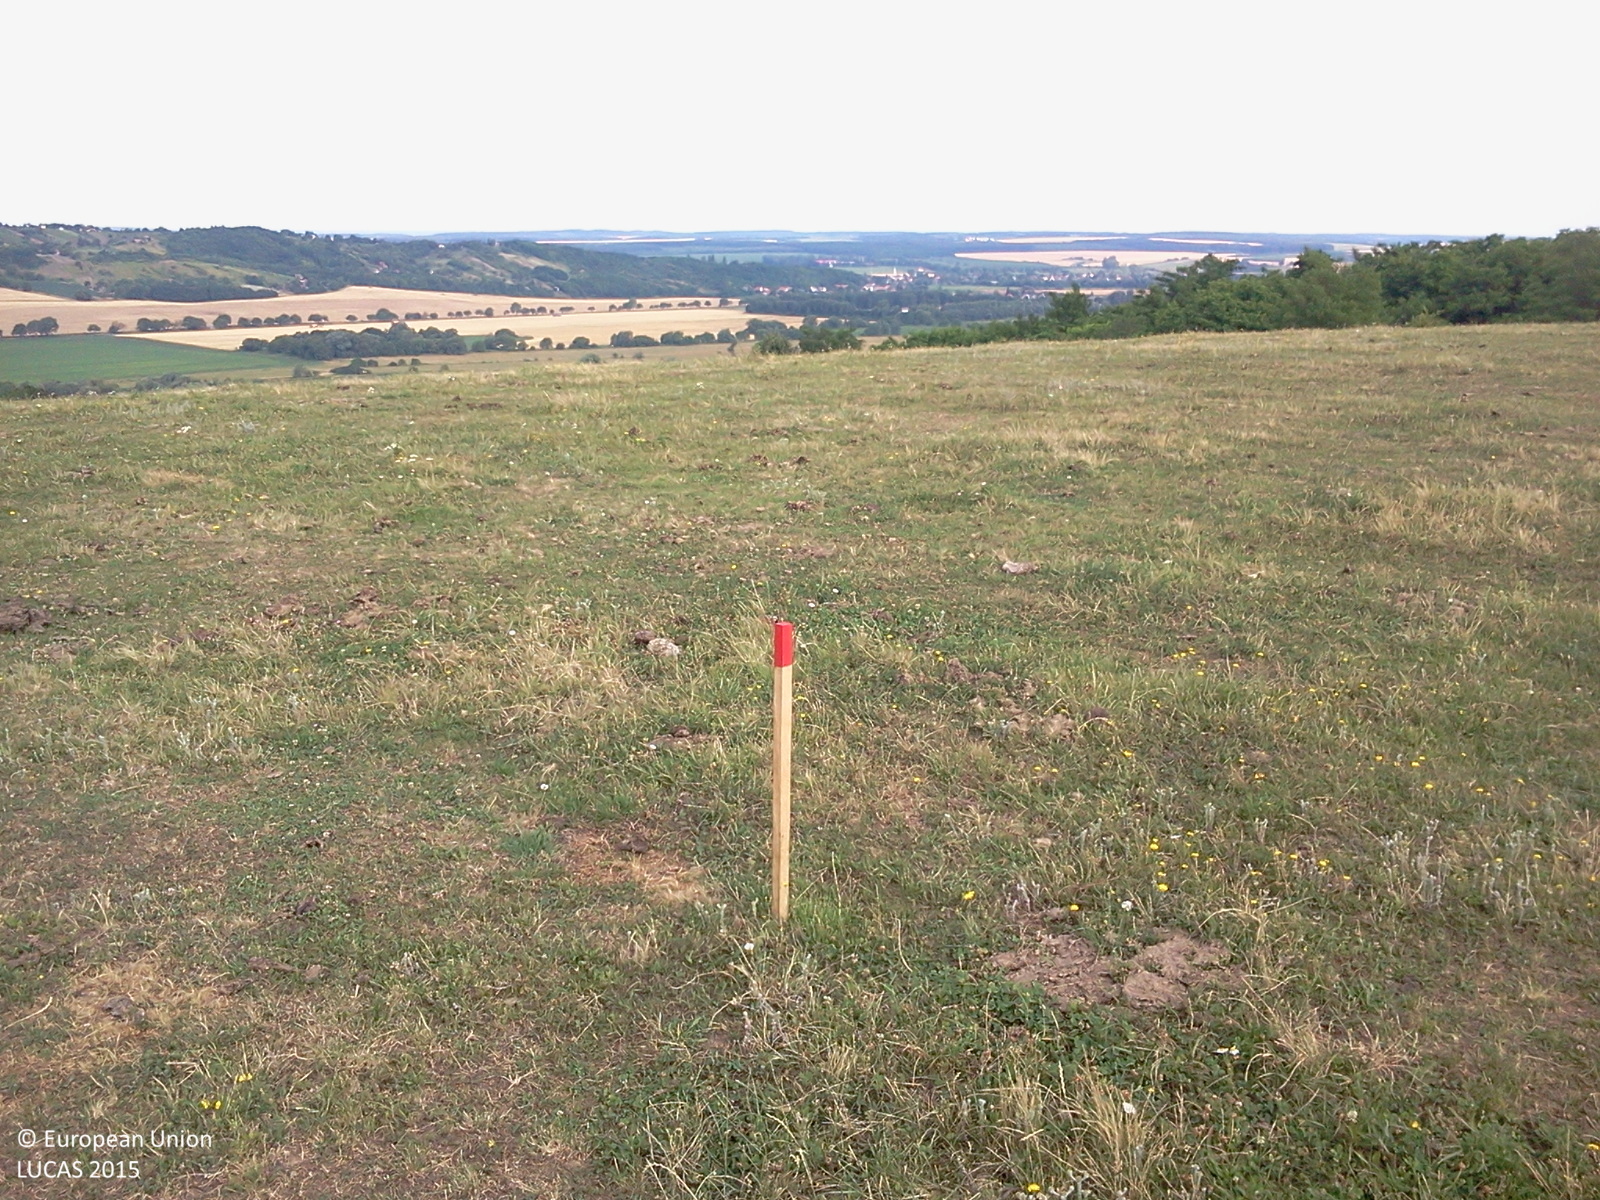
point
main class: Grassland
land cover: Grassland without tree/shrub cover
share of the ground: > 75 %
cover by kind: herbaceous plants 100 %
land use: Agriculture (excluding fallow land and kitchen gardens)
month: June
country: HU
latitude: 46.8989
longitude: 17.0004
